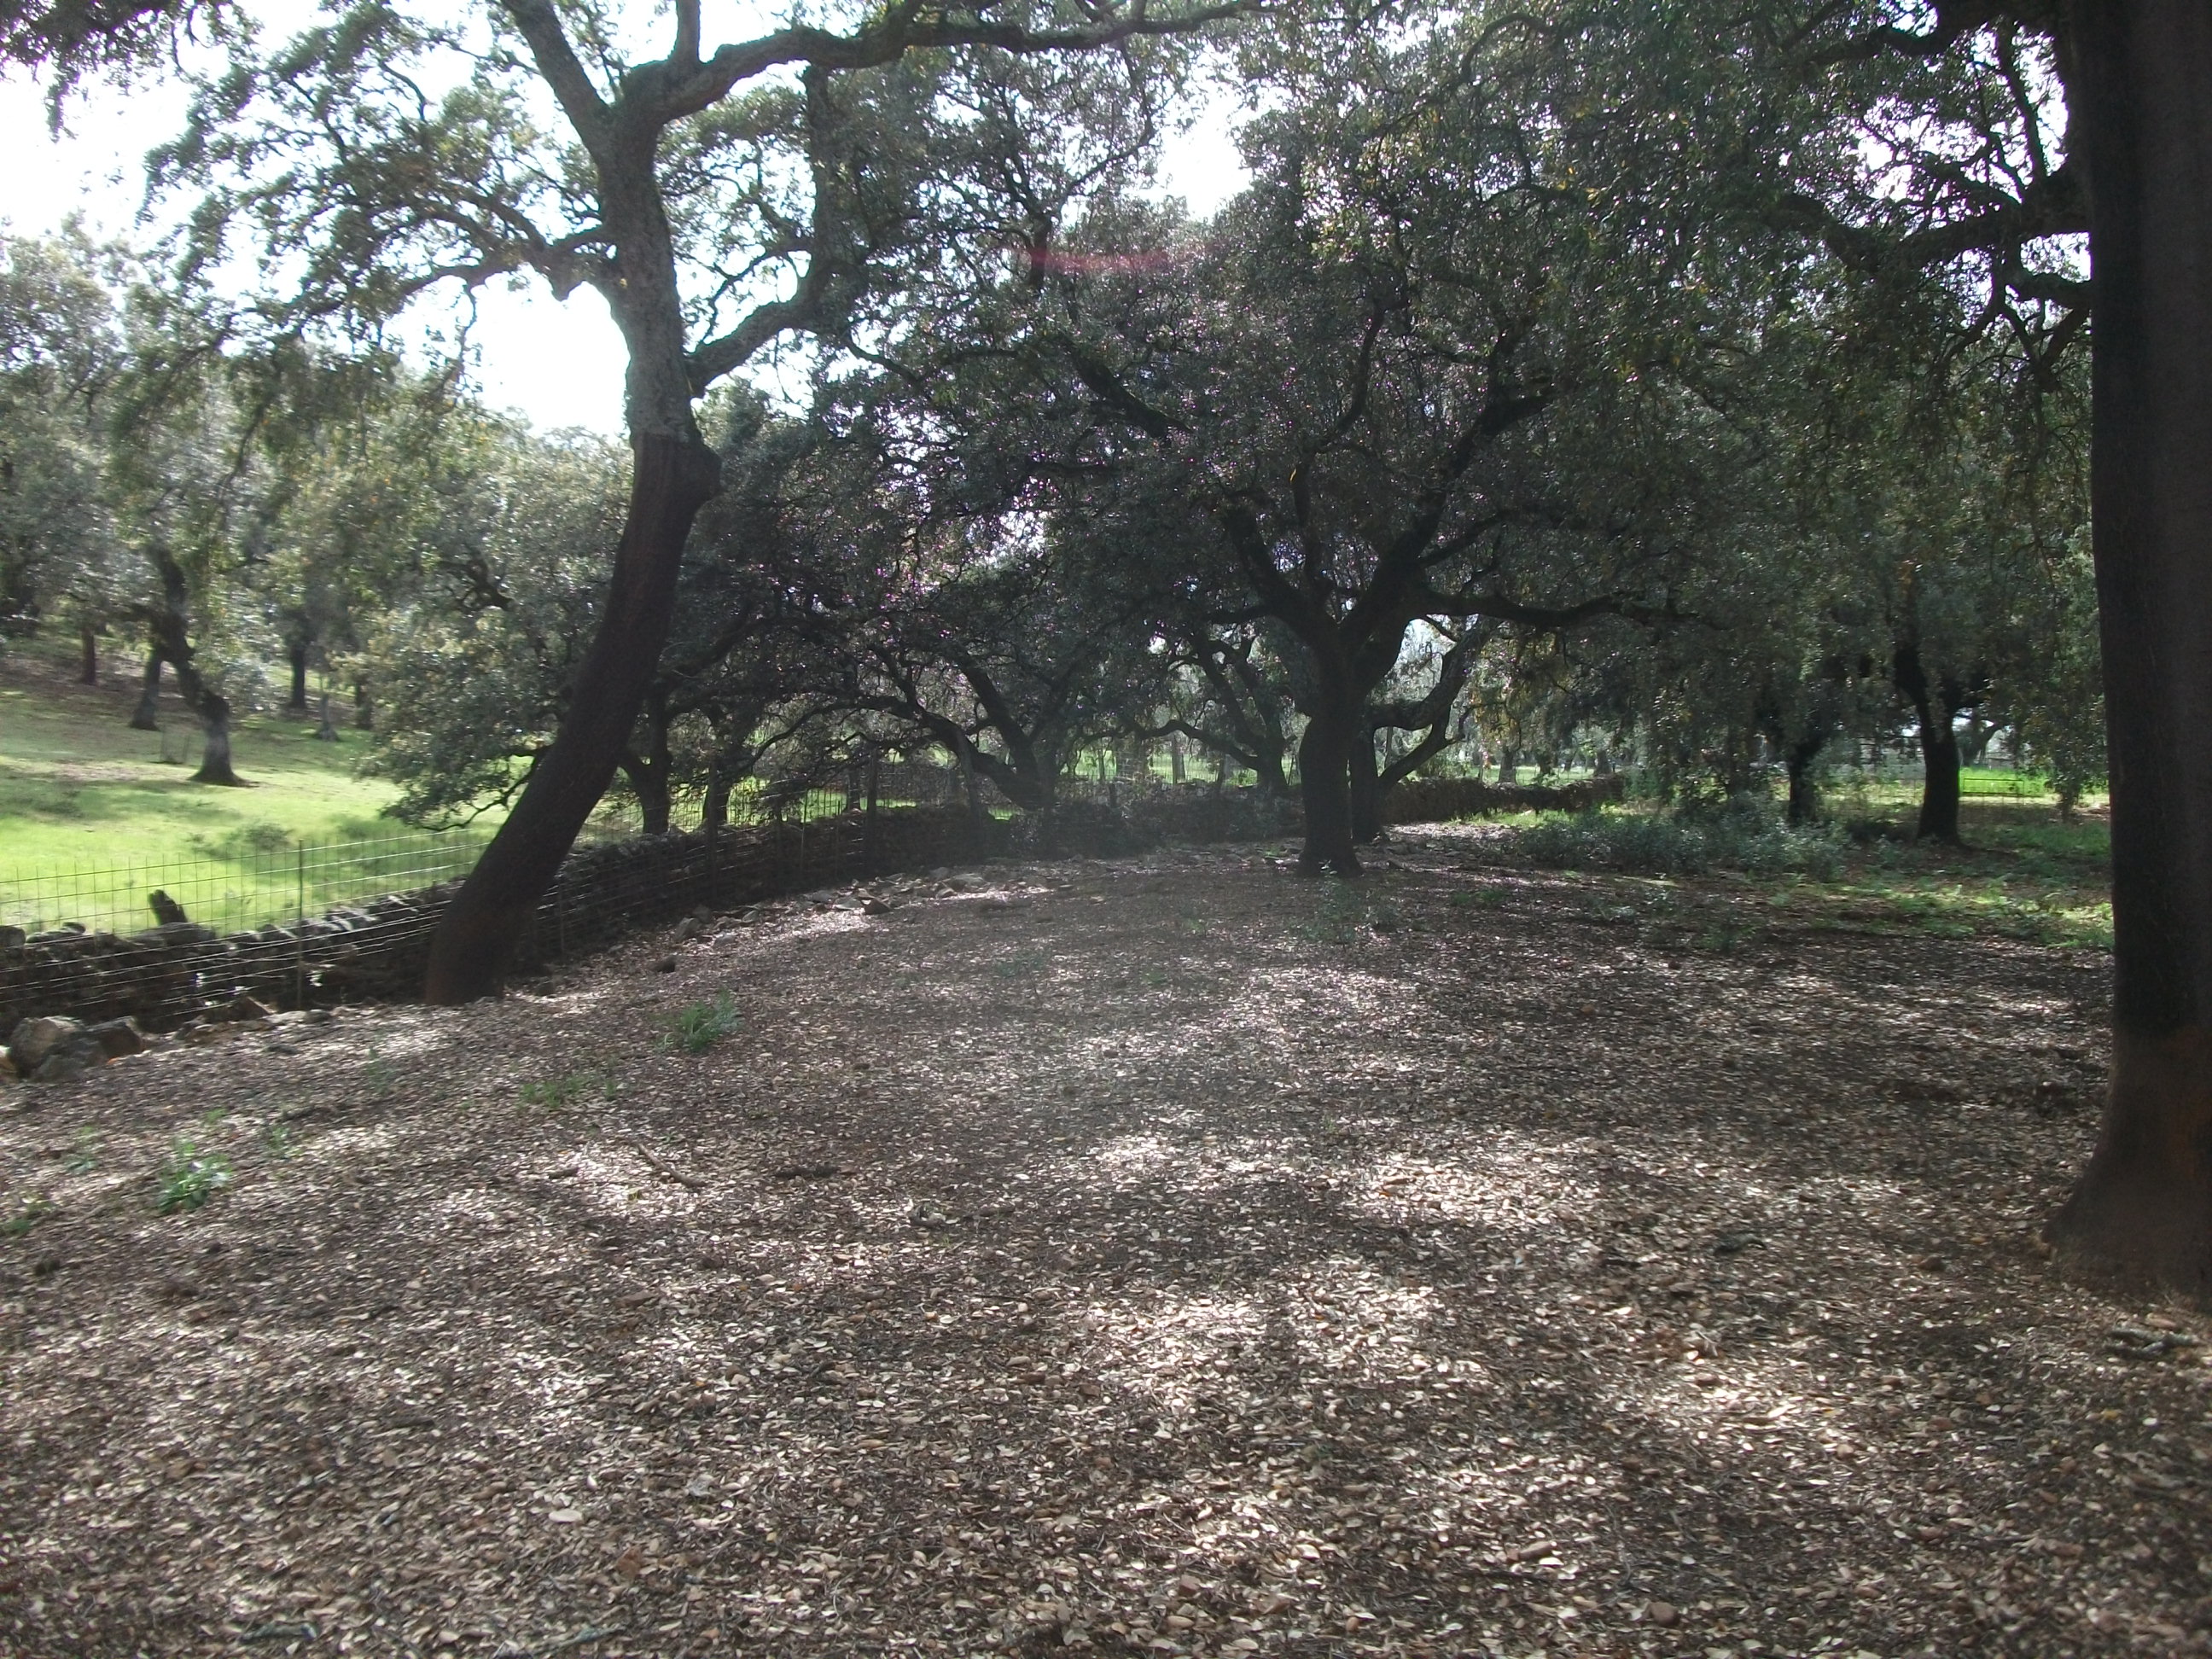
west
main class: Woodland
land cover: Broadleaved woodland
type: broadleaved evergreen forest
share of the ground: 50 - 75 %
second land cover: Spontaneously vegetated surfaces
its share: 10 - 25 %
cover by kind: broadleaved forest trees 80 %, herbaceous plants 10 %, unconsolidated bare surface 10 %
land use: Forestry
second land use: Agriculture (excluding fallow land and kitchen gardens)
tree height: > 5 m
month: April
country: ES
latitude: 37.8618
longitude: -6.5121
